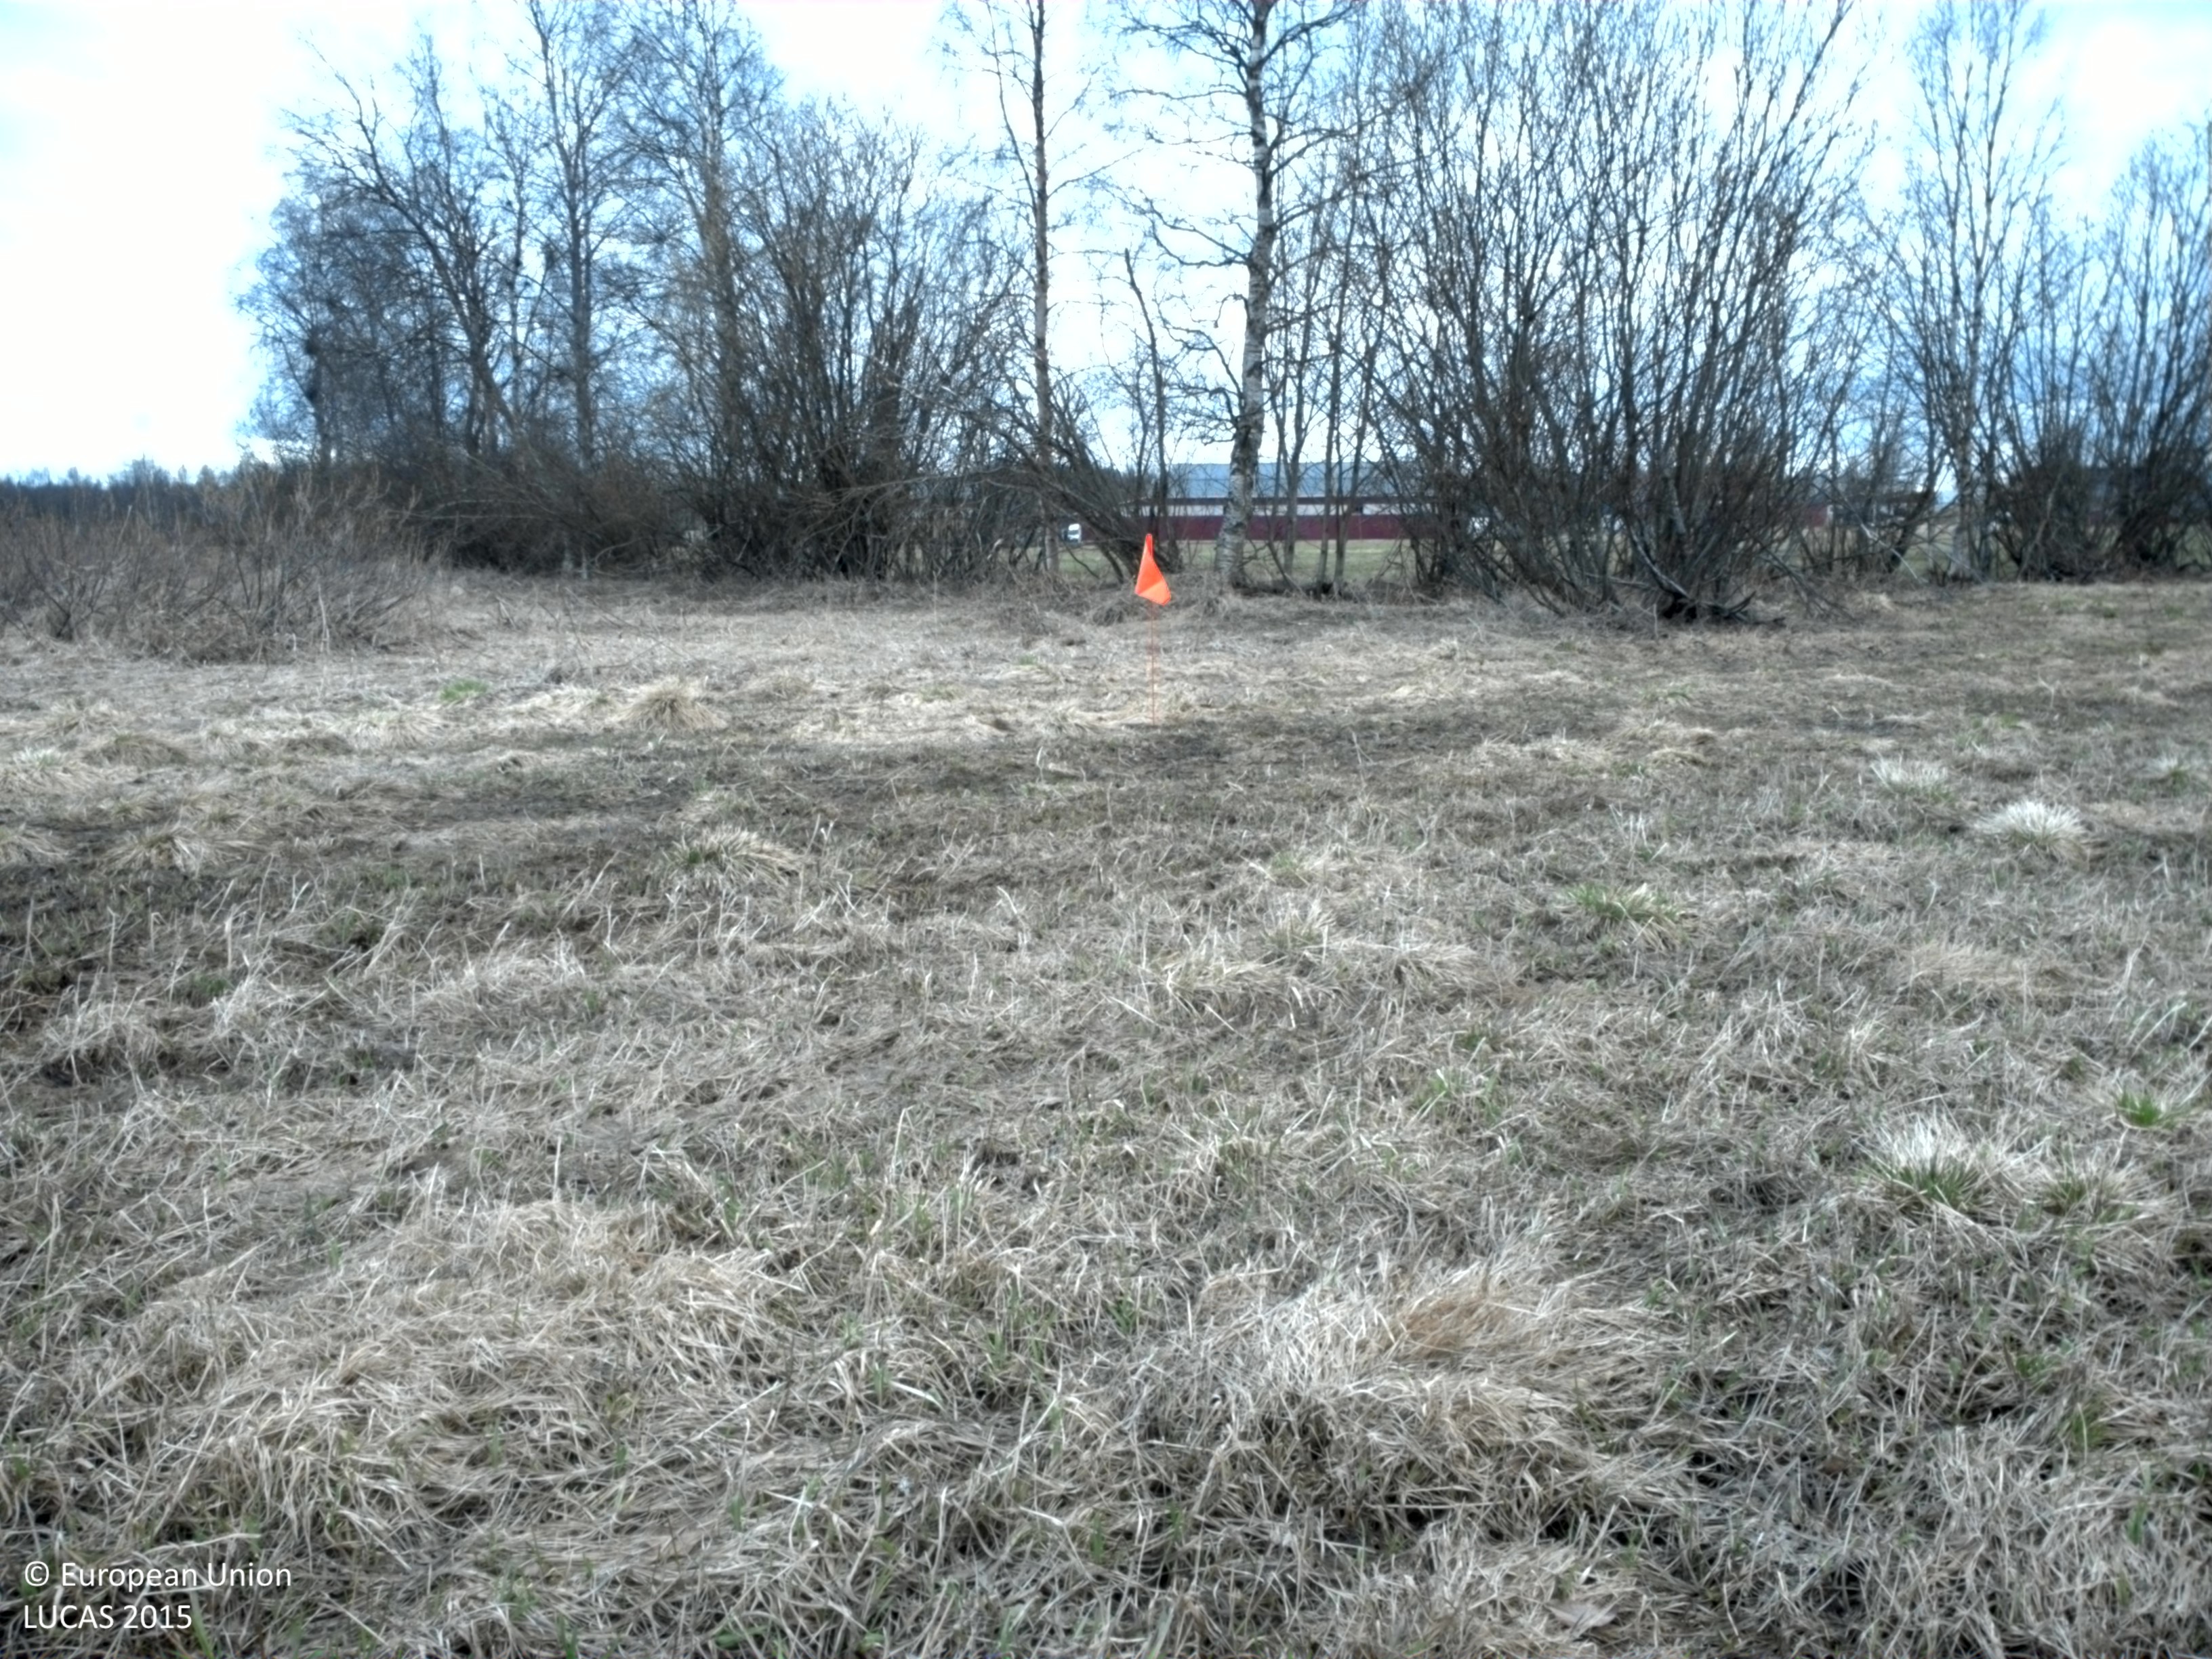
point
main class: Cropland
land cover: Temporary grasslands
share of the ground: > 75 %
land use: Agriculture (excluding fallow land and kitchen gardens)
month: May
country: SE
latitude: 65.8303
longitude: 24.0762
